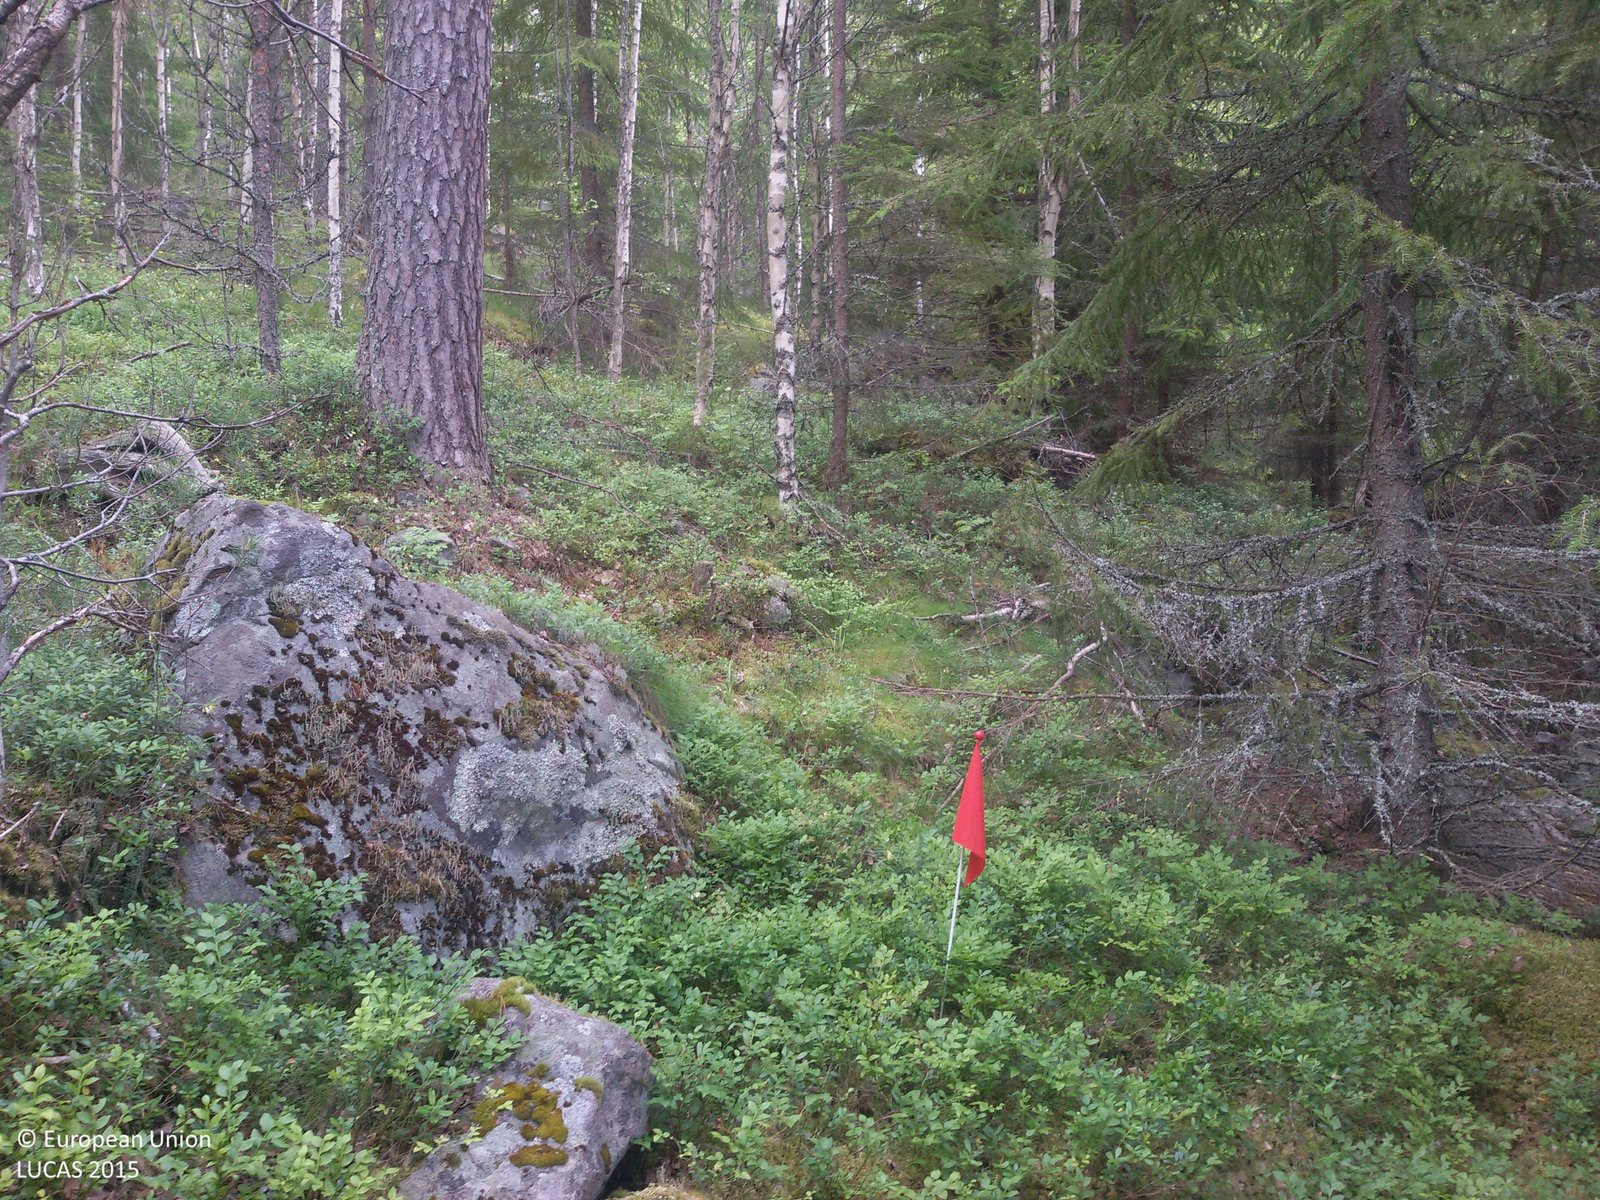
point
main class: Woodland
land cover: Spruce dominated mixed woodland
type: boreal forest
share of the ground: 50 - 75 %
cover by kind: coniferous forest trees 40 %, broadleaved forest trees 35 %, herbaceous plants 15 %, lichens and mosses 10 %
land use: Forestry
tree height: > 5 m
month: July
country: SE
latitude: 60.5506
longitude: 15.2936
